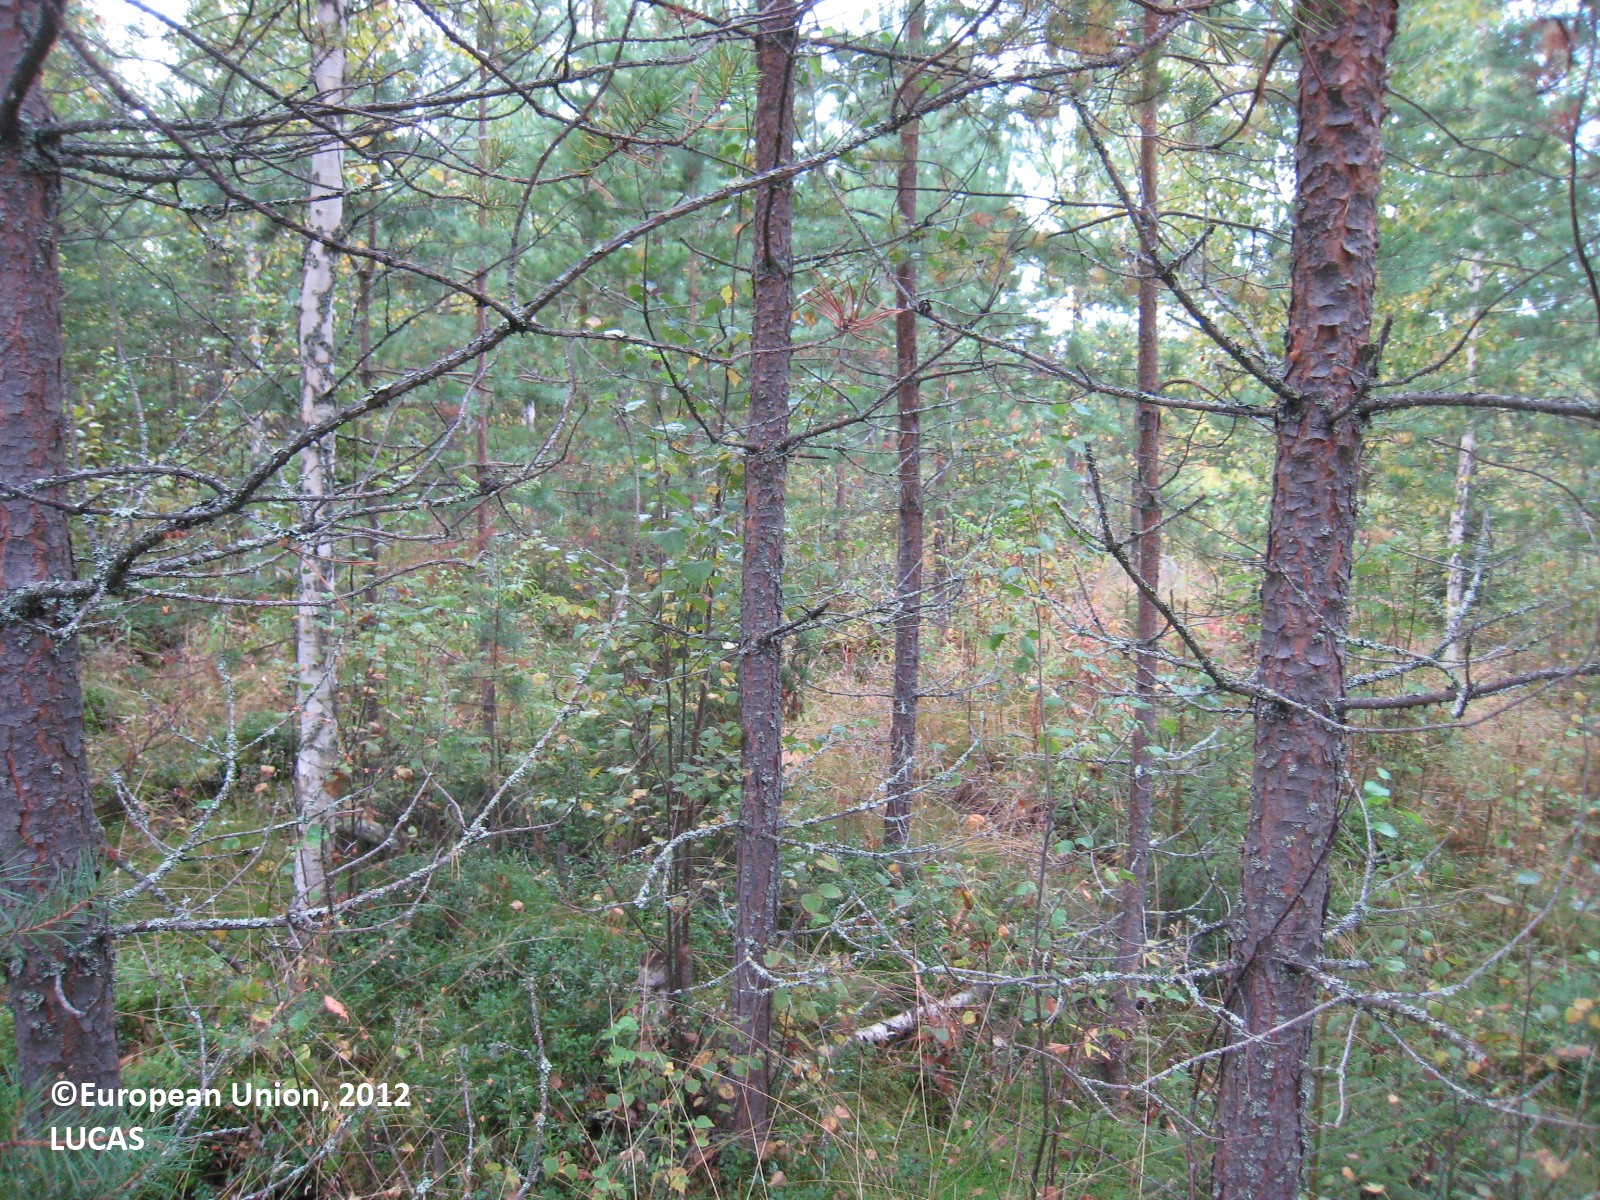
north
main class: Woodland
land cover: Pine dominated mixed woodland
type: boreal forest
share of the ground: > 75 %
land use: Forestry
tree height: > 5 m
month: August
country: FI
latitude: 62.1459
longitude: 27.2182
